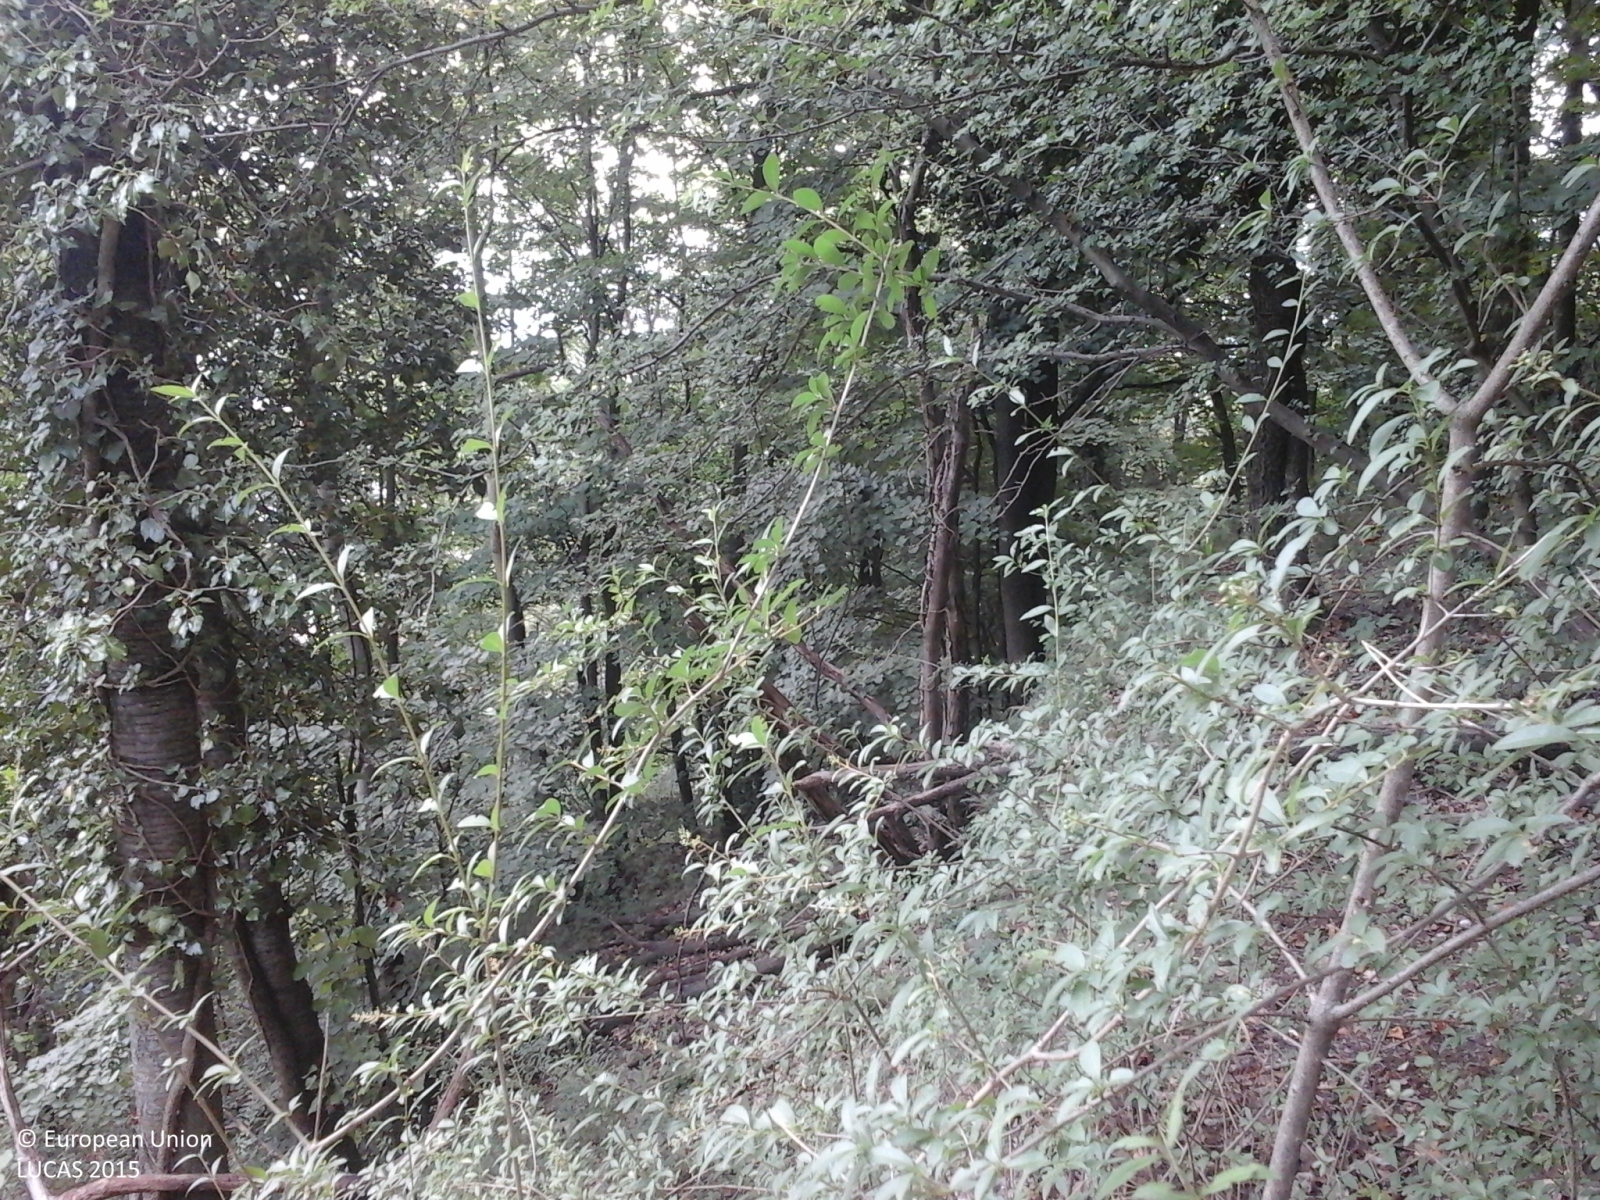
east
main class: Woodland
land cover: Broadleaved woodland
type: thermophilous deciduous forest
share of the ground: > 75 %
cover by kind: broadleaved forest trees 100 %
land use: Forestry
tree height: > 5 m
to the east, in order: Broadleaved woodland
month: July
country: IT
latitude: 45.1072
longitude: 7.2212
